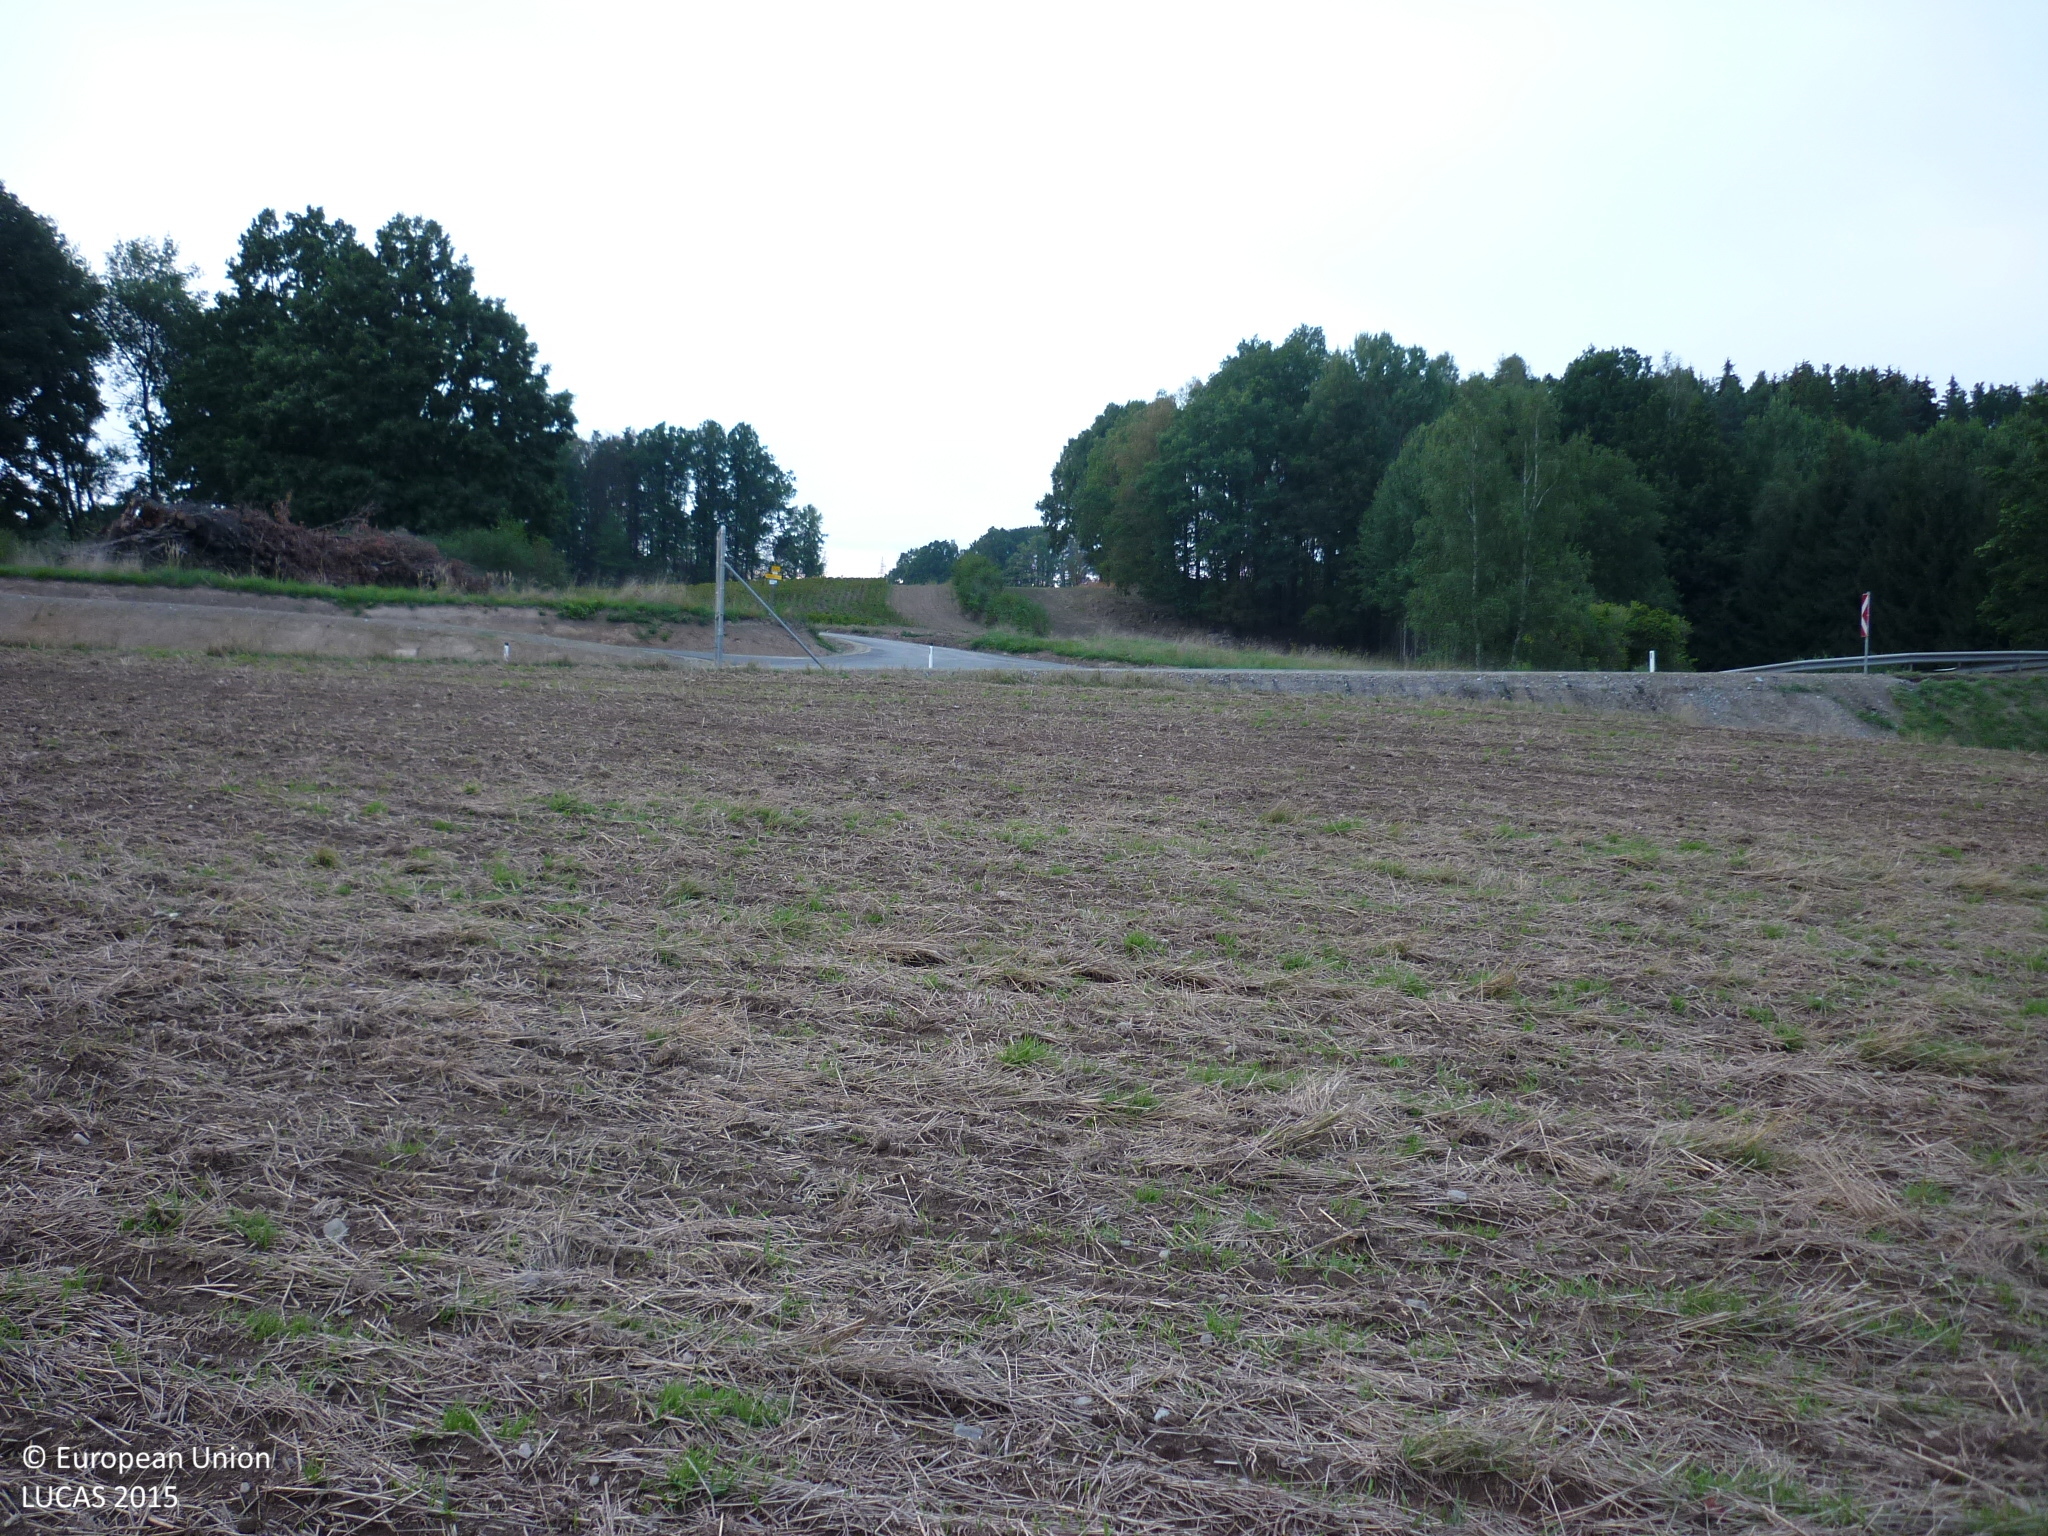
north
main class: Grassland
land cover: Spontaneously vegetated surfaces
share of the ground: 10 - 25 %
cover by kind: unconsolidated bare surface 85 %, herbaceous plants 15 %
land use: Agriculture (excluding fallow land and kitchen gardens)
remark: Harvested field
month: September
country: AT
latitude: 48.7761
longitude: 15.0233
